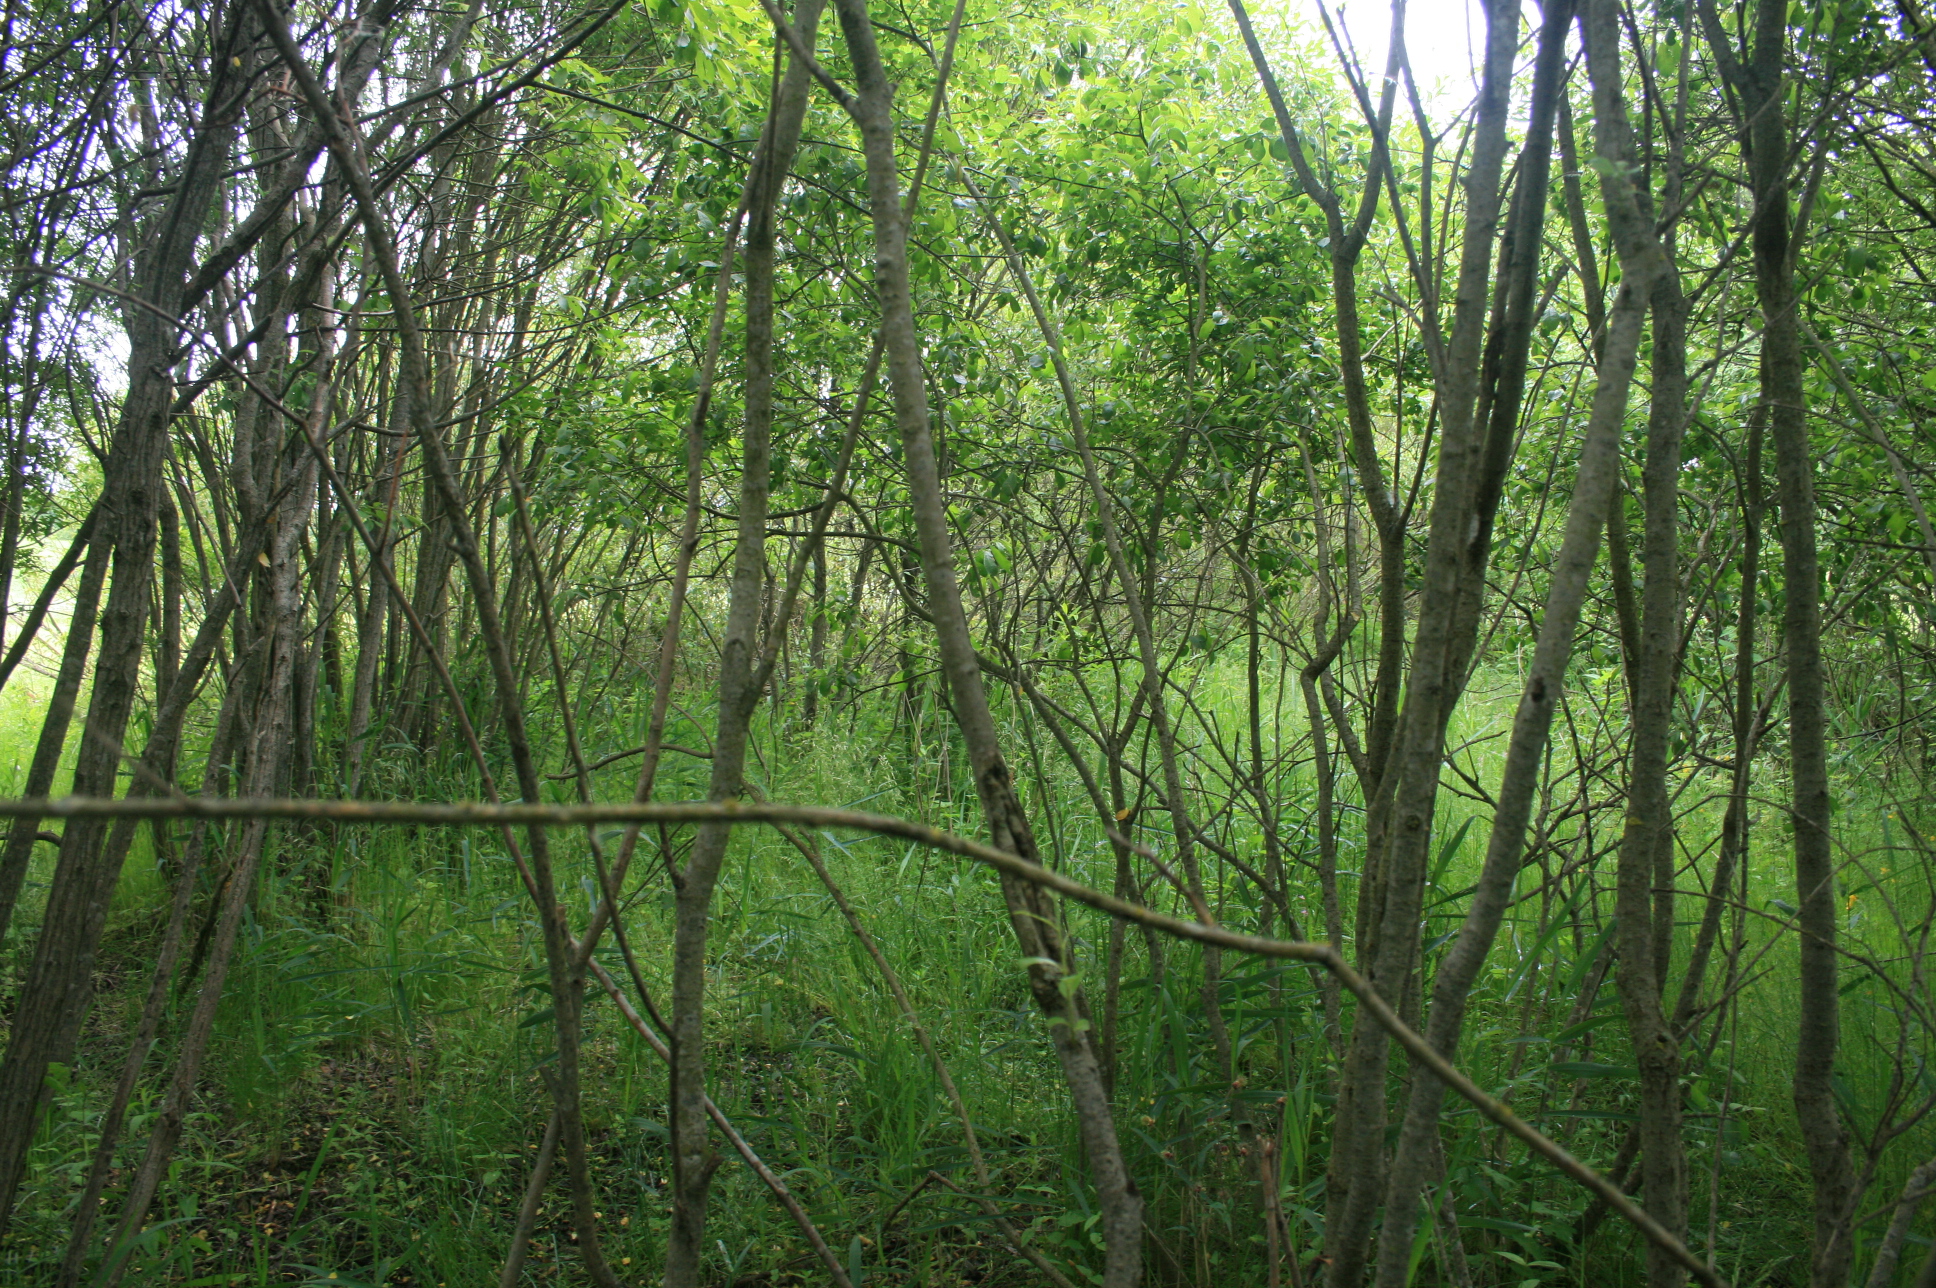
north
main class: Woodland
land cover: Broadleaved woodland
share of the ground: > 75 %
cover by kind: broadleaved forest trees 85 %, herbaceous plants 10 %, shrubs 5 %
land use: Semi-natural and natural areas not in use
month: June
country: LT
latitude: 55.6762
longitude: 22.3824
